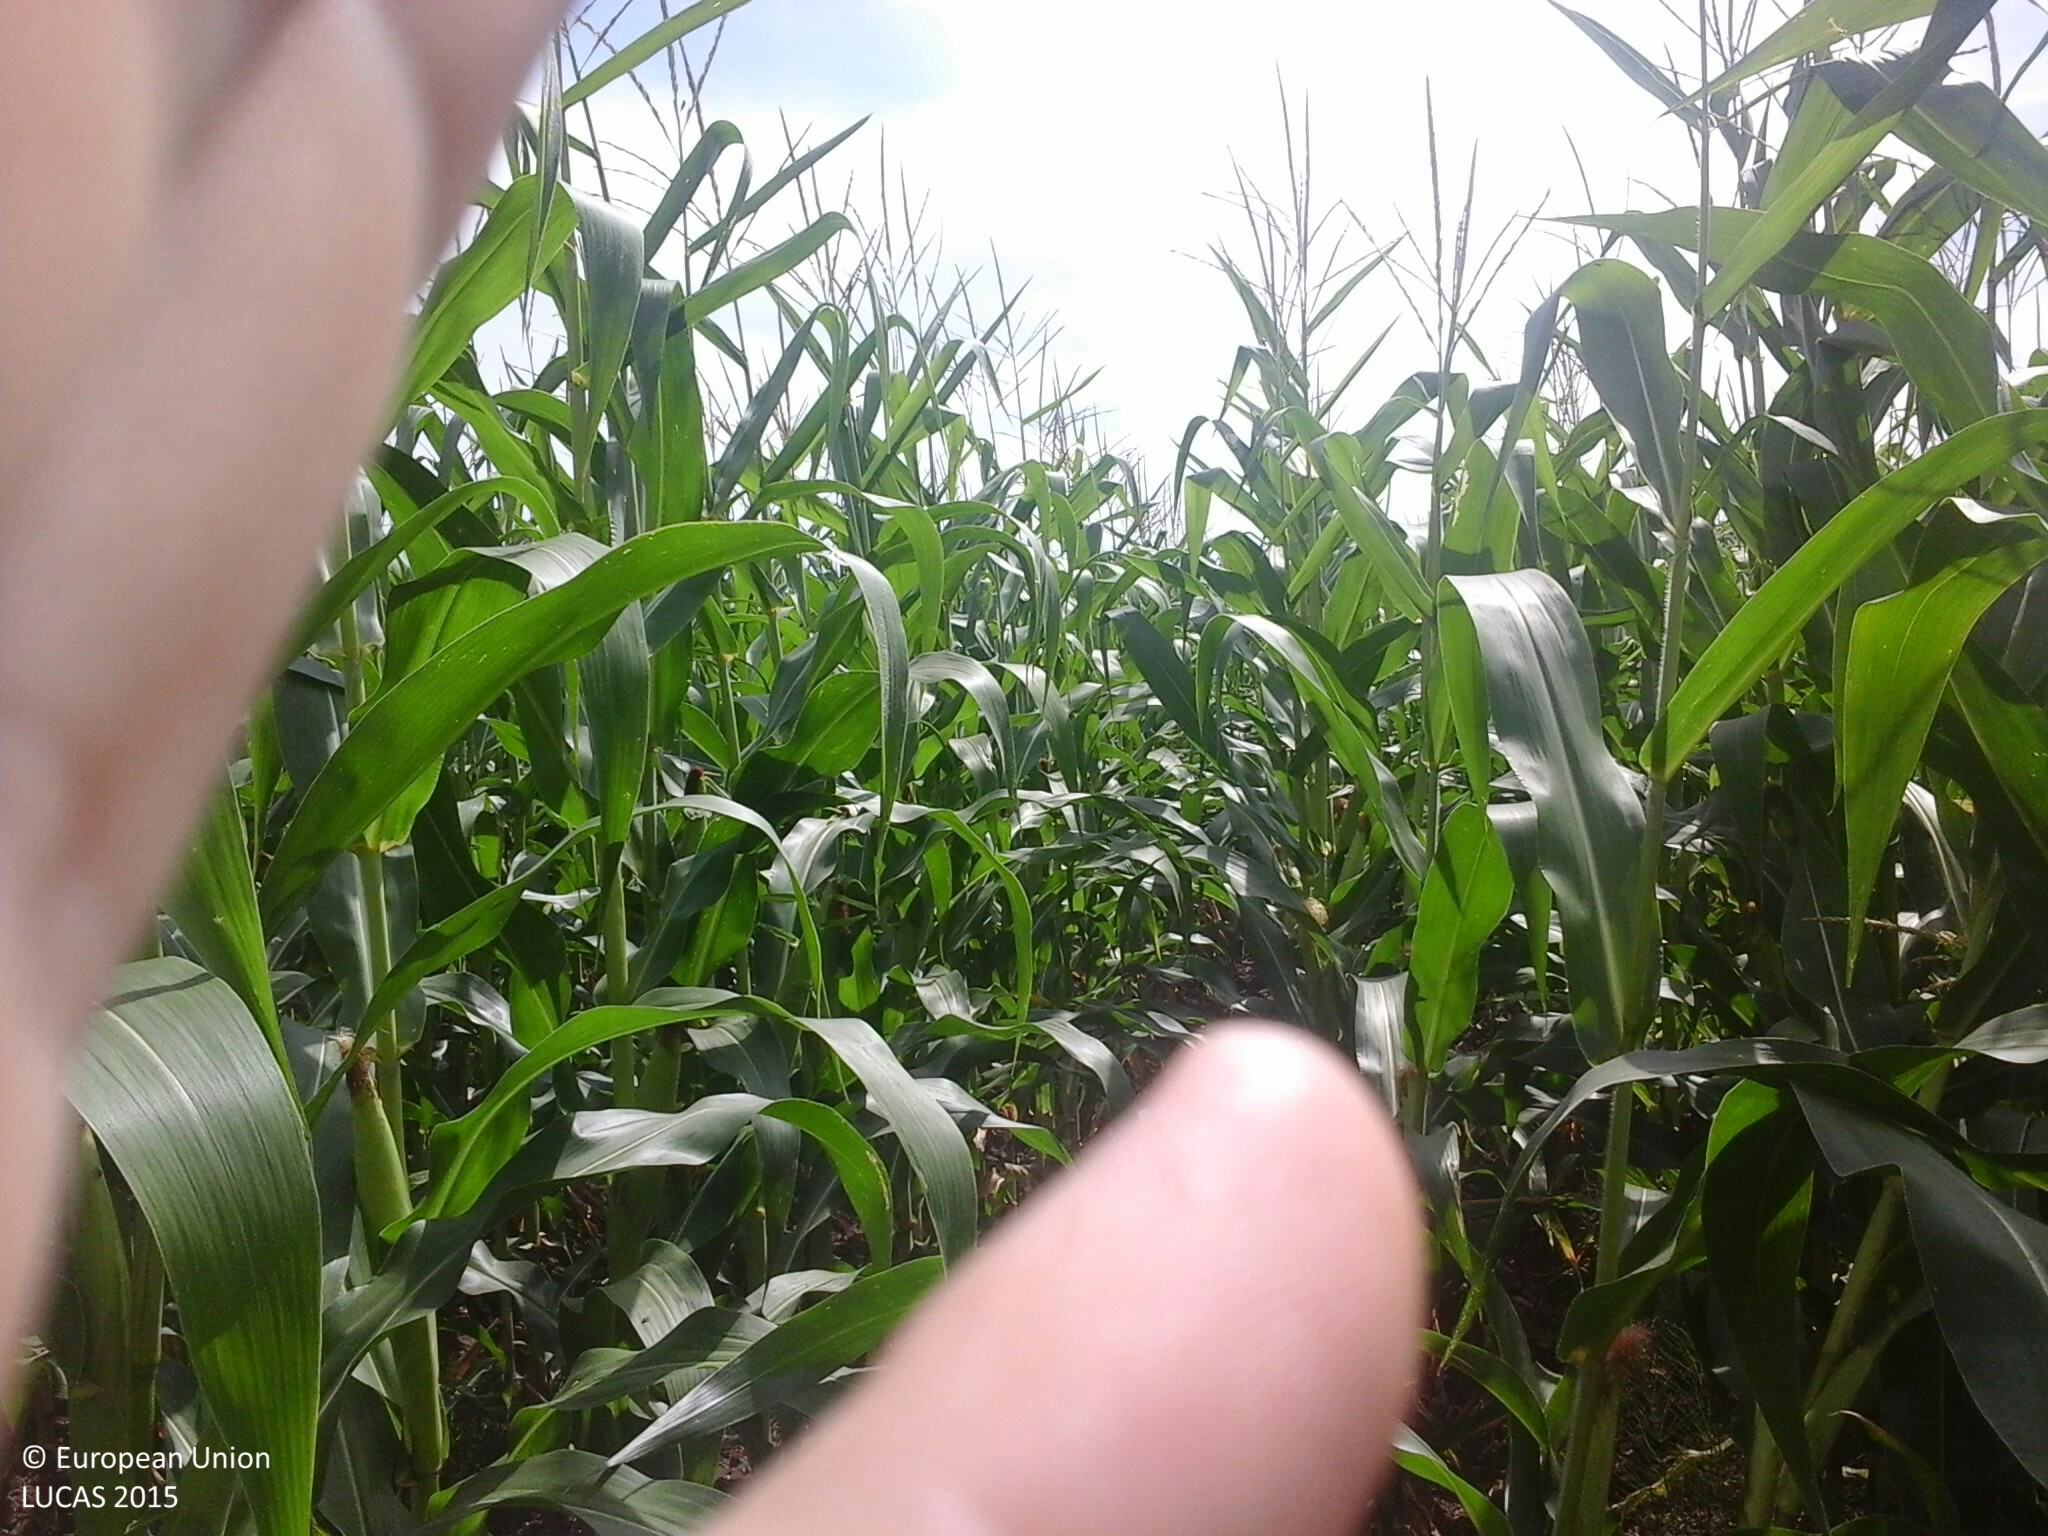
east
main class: Cropland
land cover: Maize
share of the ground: > 75 %
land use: Agriculture (excluding fallow land and kitchen gardens)
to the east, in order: Maize; Grass margins; Fences; Nuts trees
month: July
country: HU
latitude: 48.2801
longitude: 22.2797
